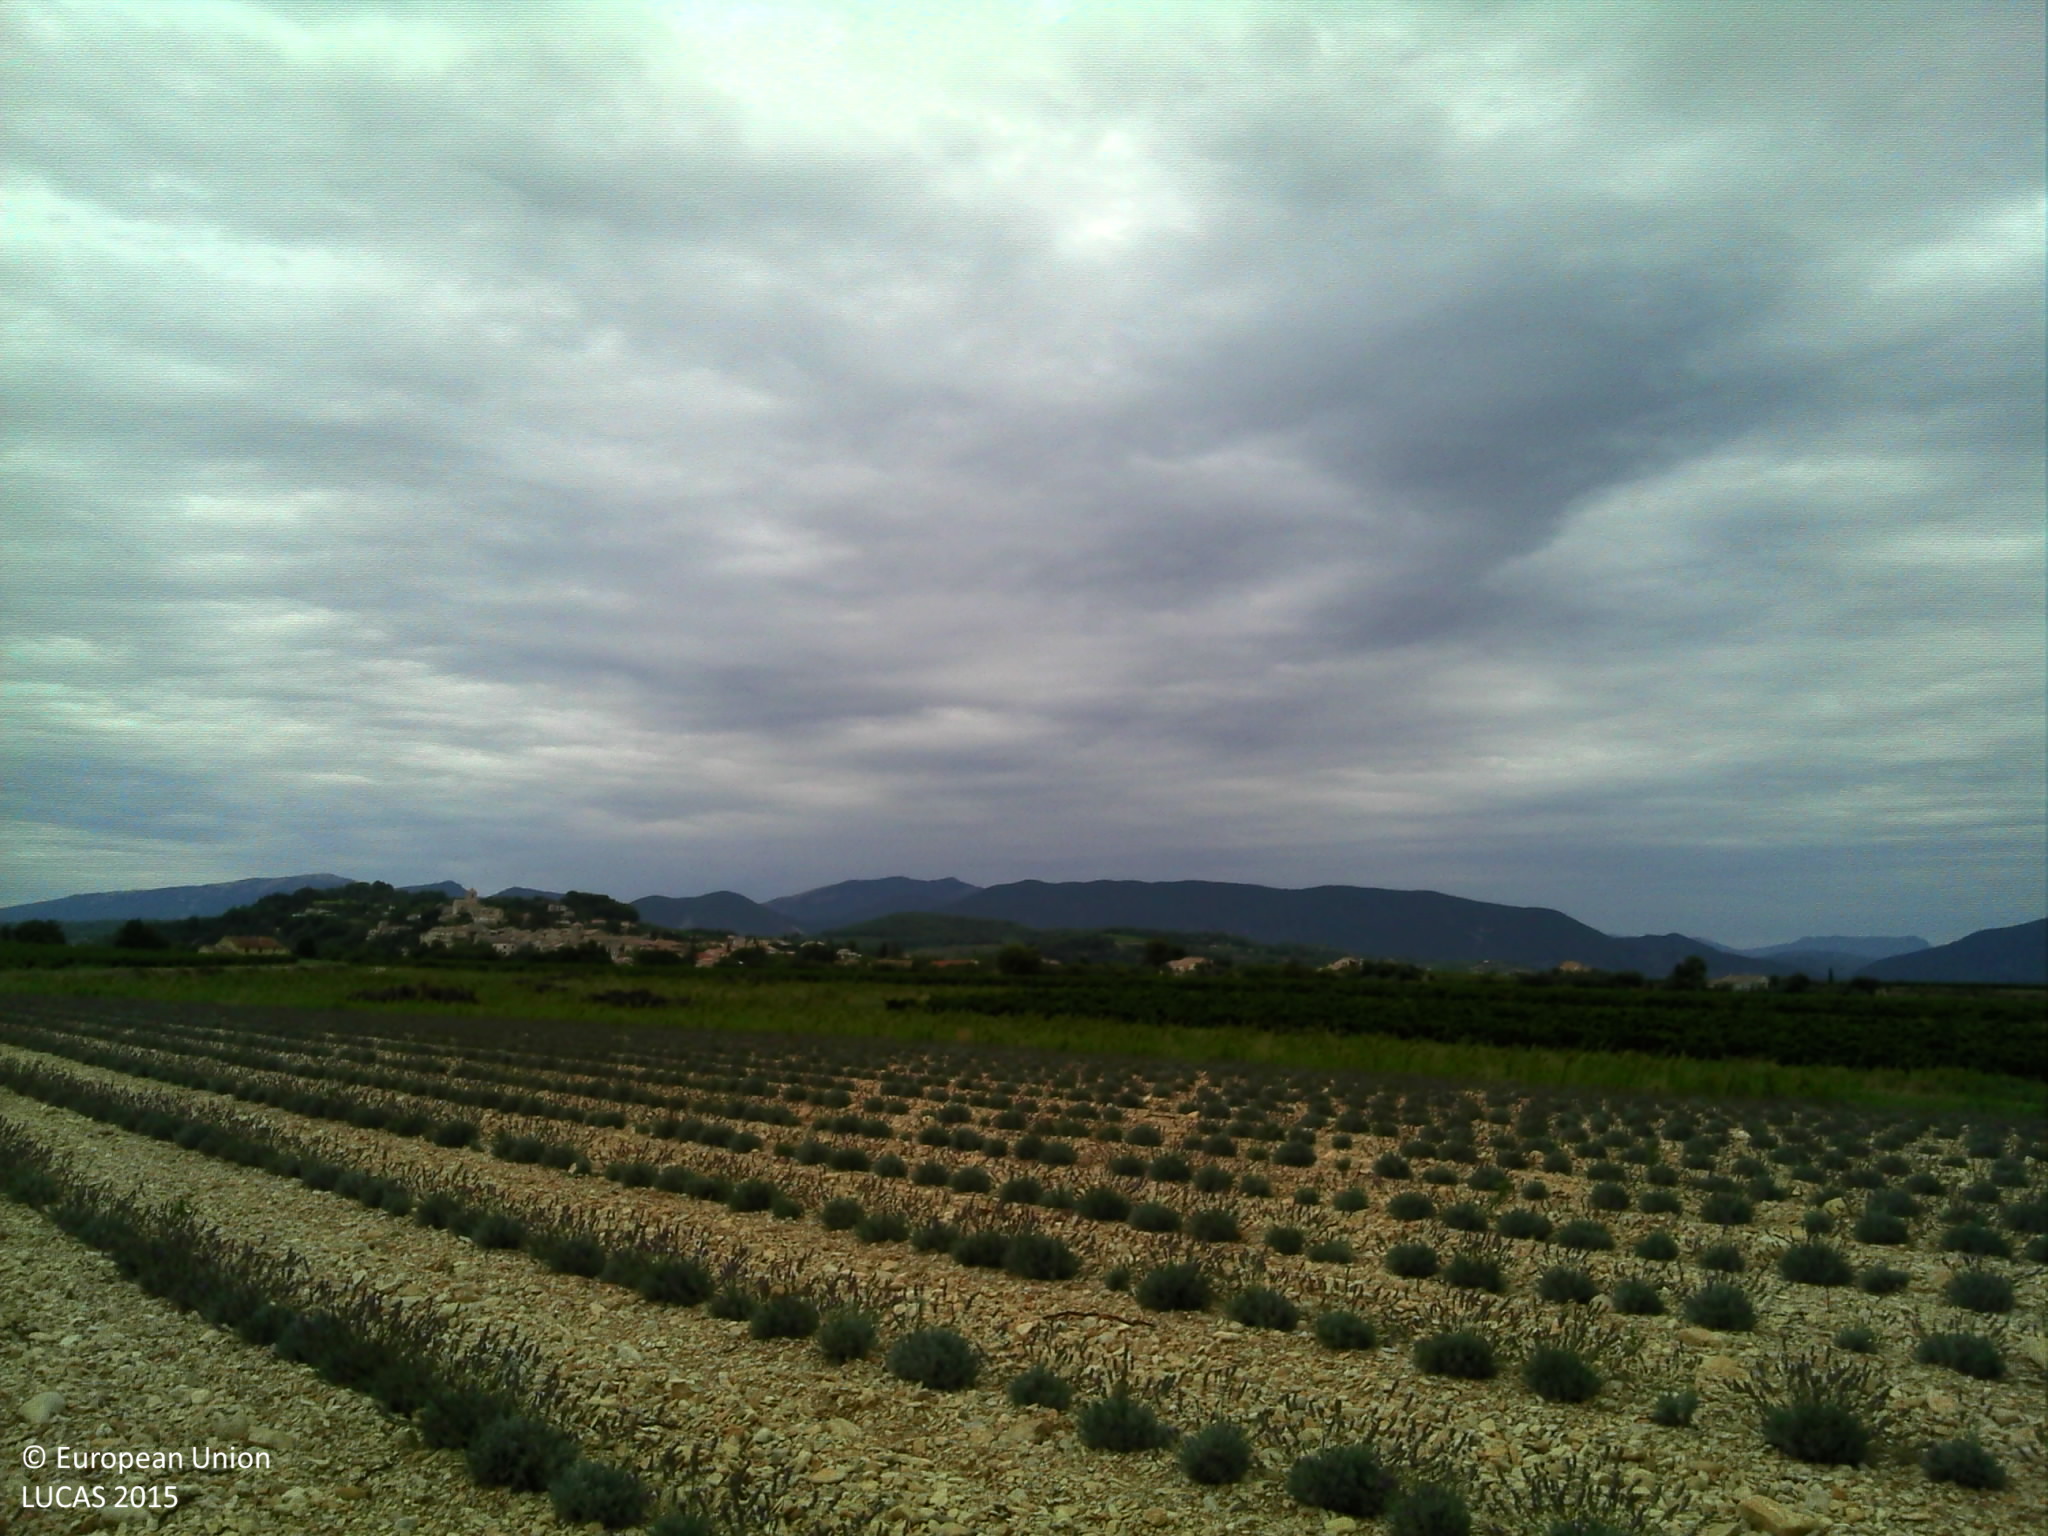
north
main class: Cropland
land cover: Permanent industrial crops
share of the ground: 10 - 25 %
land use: Agriculture (excluding fallow land and kitchen gardens)
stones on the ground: 25 - 50 %
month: September
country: FR
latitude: 44.3230
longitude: 5.0545
